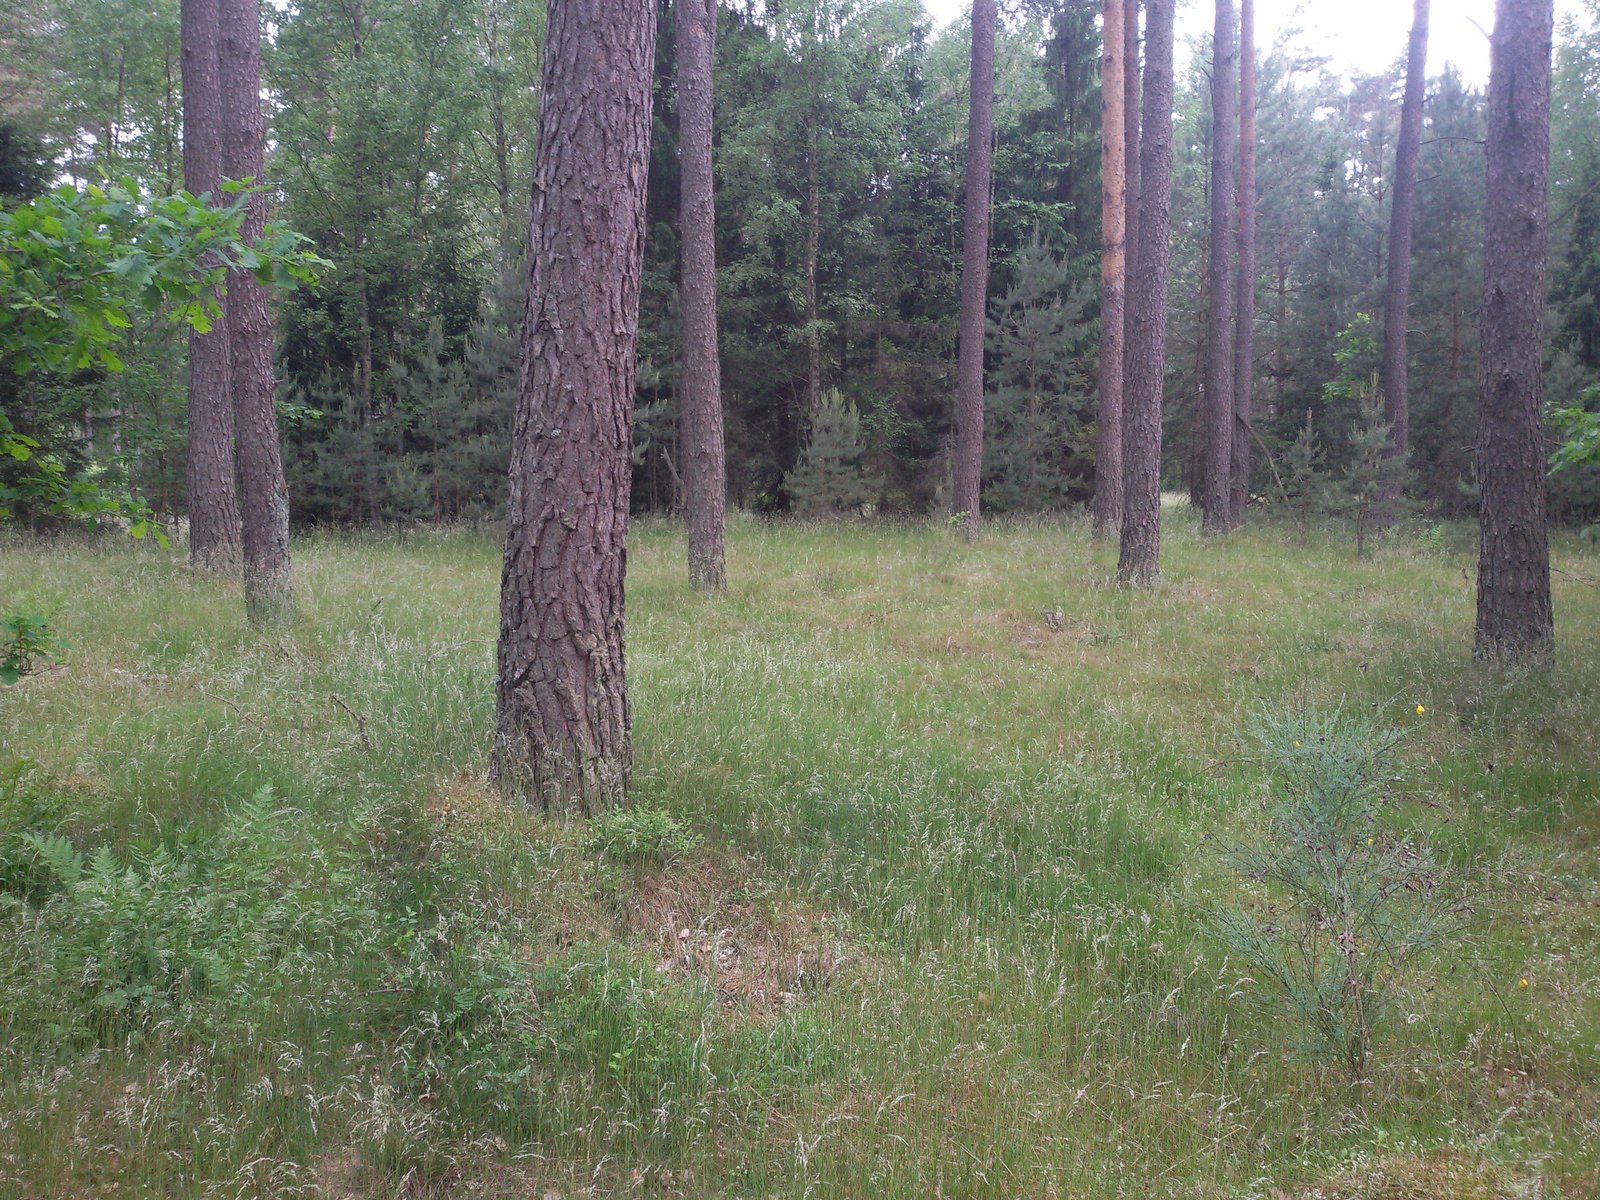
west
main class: Woodland
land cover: Pine dominated coniferous woodland
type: hemiboreal forest and nemoral coniferous forest and mixed broadleaved-coniferous forest
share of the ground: 50 - 75 %
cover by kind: coniferous forest trees 50 %, herbaceous plants 45 %, broadleaved forest trees 5 %
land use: Forestry
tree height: > 5 m
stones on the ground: 10 - 25 %
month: June
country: PL
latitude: 53.3748
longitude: 16.0929
